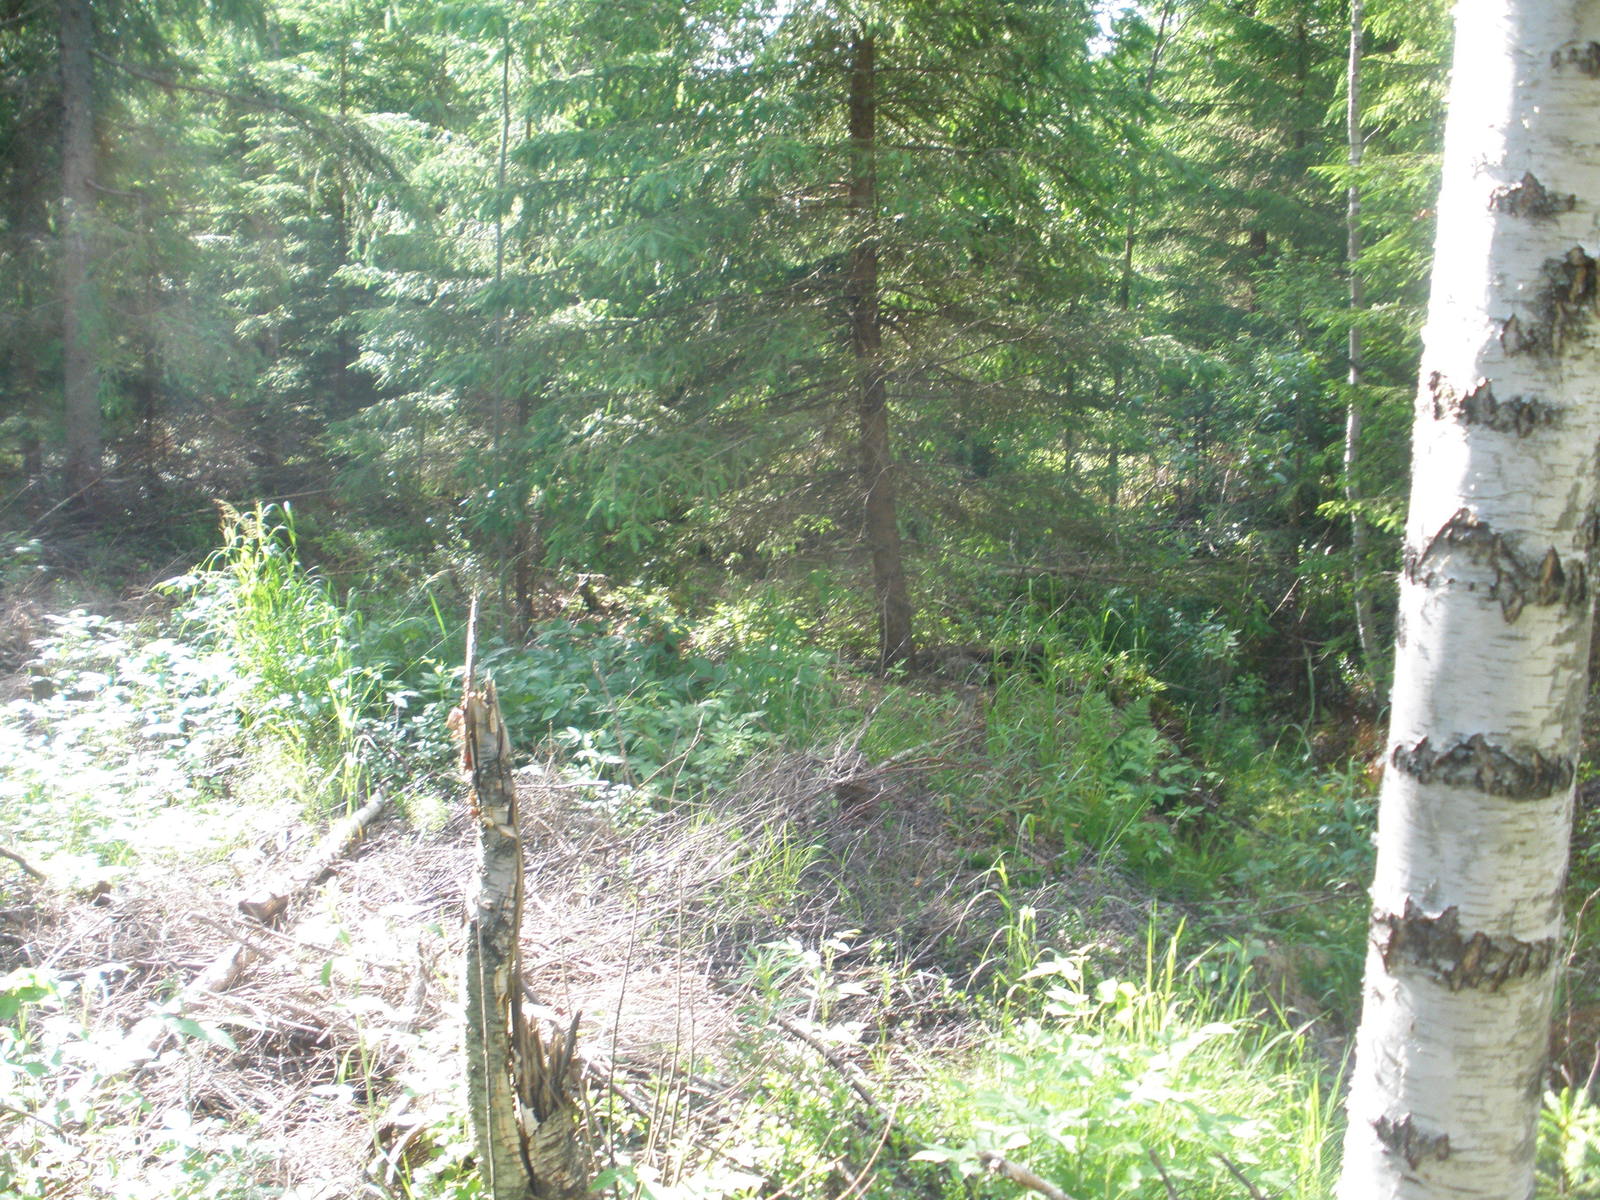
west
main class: Woodland
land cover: Spruce dominated mixed woodland
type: boreal forest
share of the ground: > 75 %
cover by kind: coniferous forest trees 55 %, broadleaved forest trees 25 %, shrubs 5 %, herbaceous plants 5 %, lichens and mosses 5 %
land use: Forestry
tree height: > 5 m
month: June
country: FI
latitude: 61.0979
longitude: 24.6654
